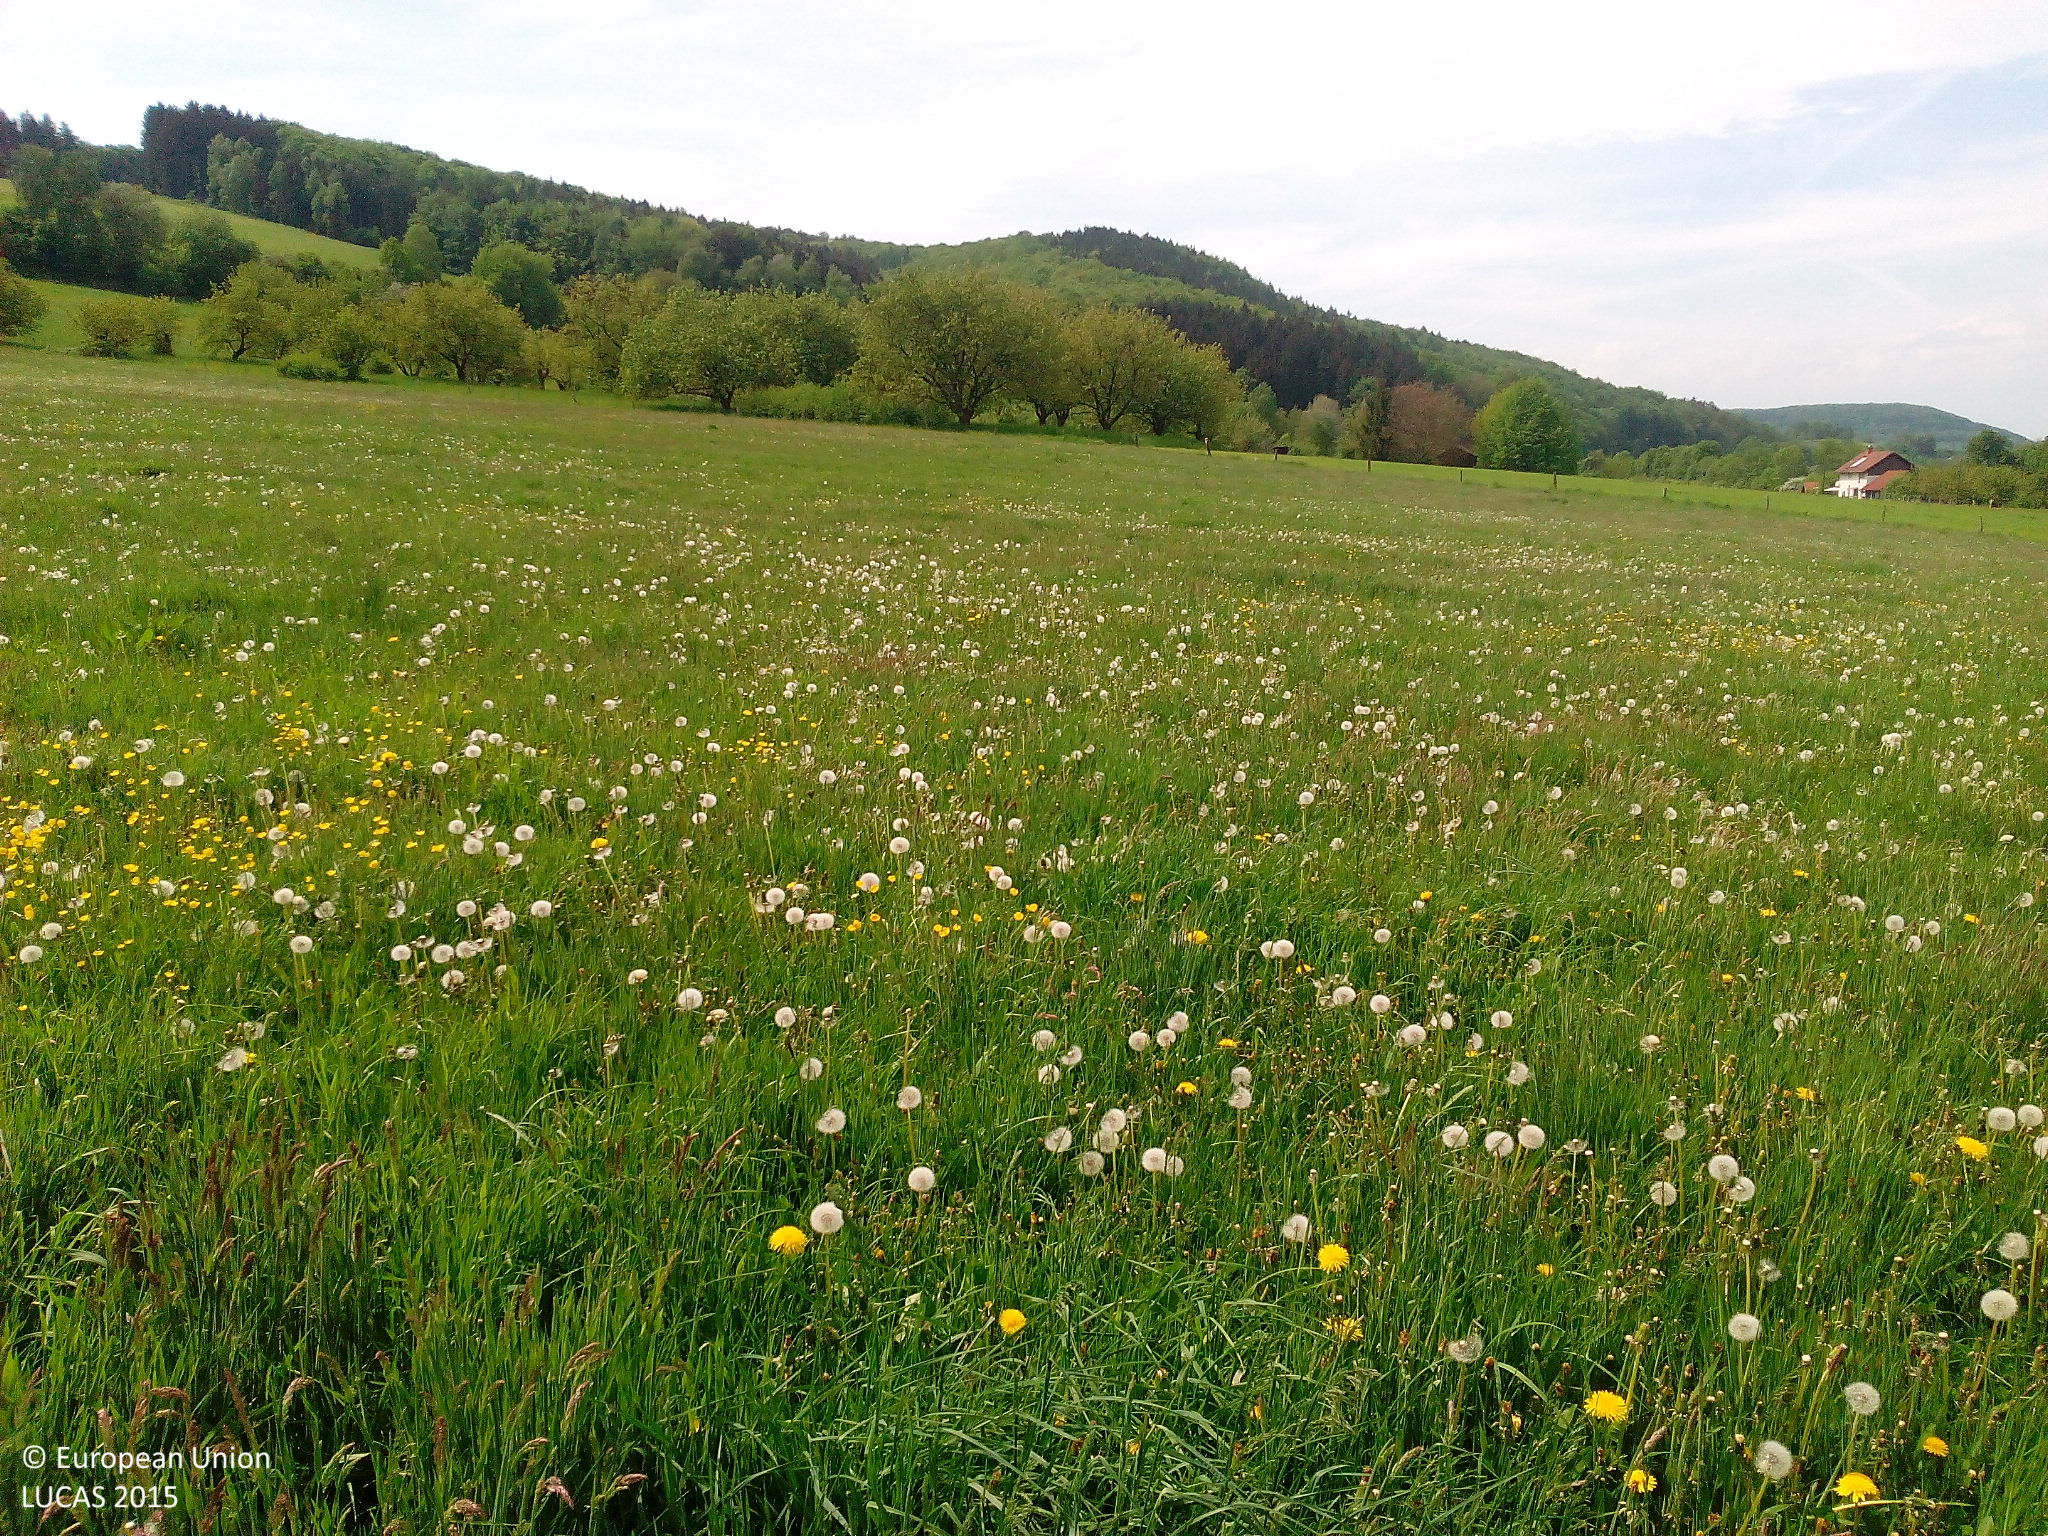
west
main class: Grassland
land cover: Grassland without tree/shrub cover
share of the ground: > 75 %
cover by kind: herbaceous plants 100 %
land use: Agriculture (excluding fallow land and kitchen gardens)
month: May
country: DE
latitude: 51.2989
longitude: 9.9570
